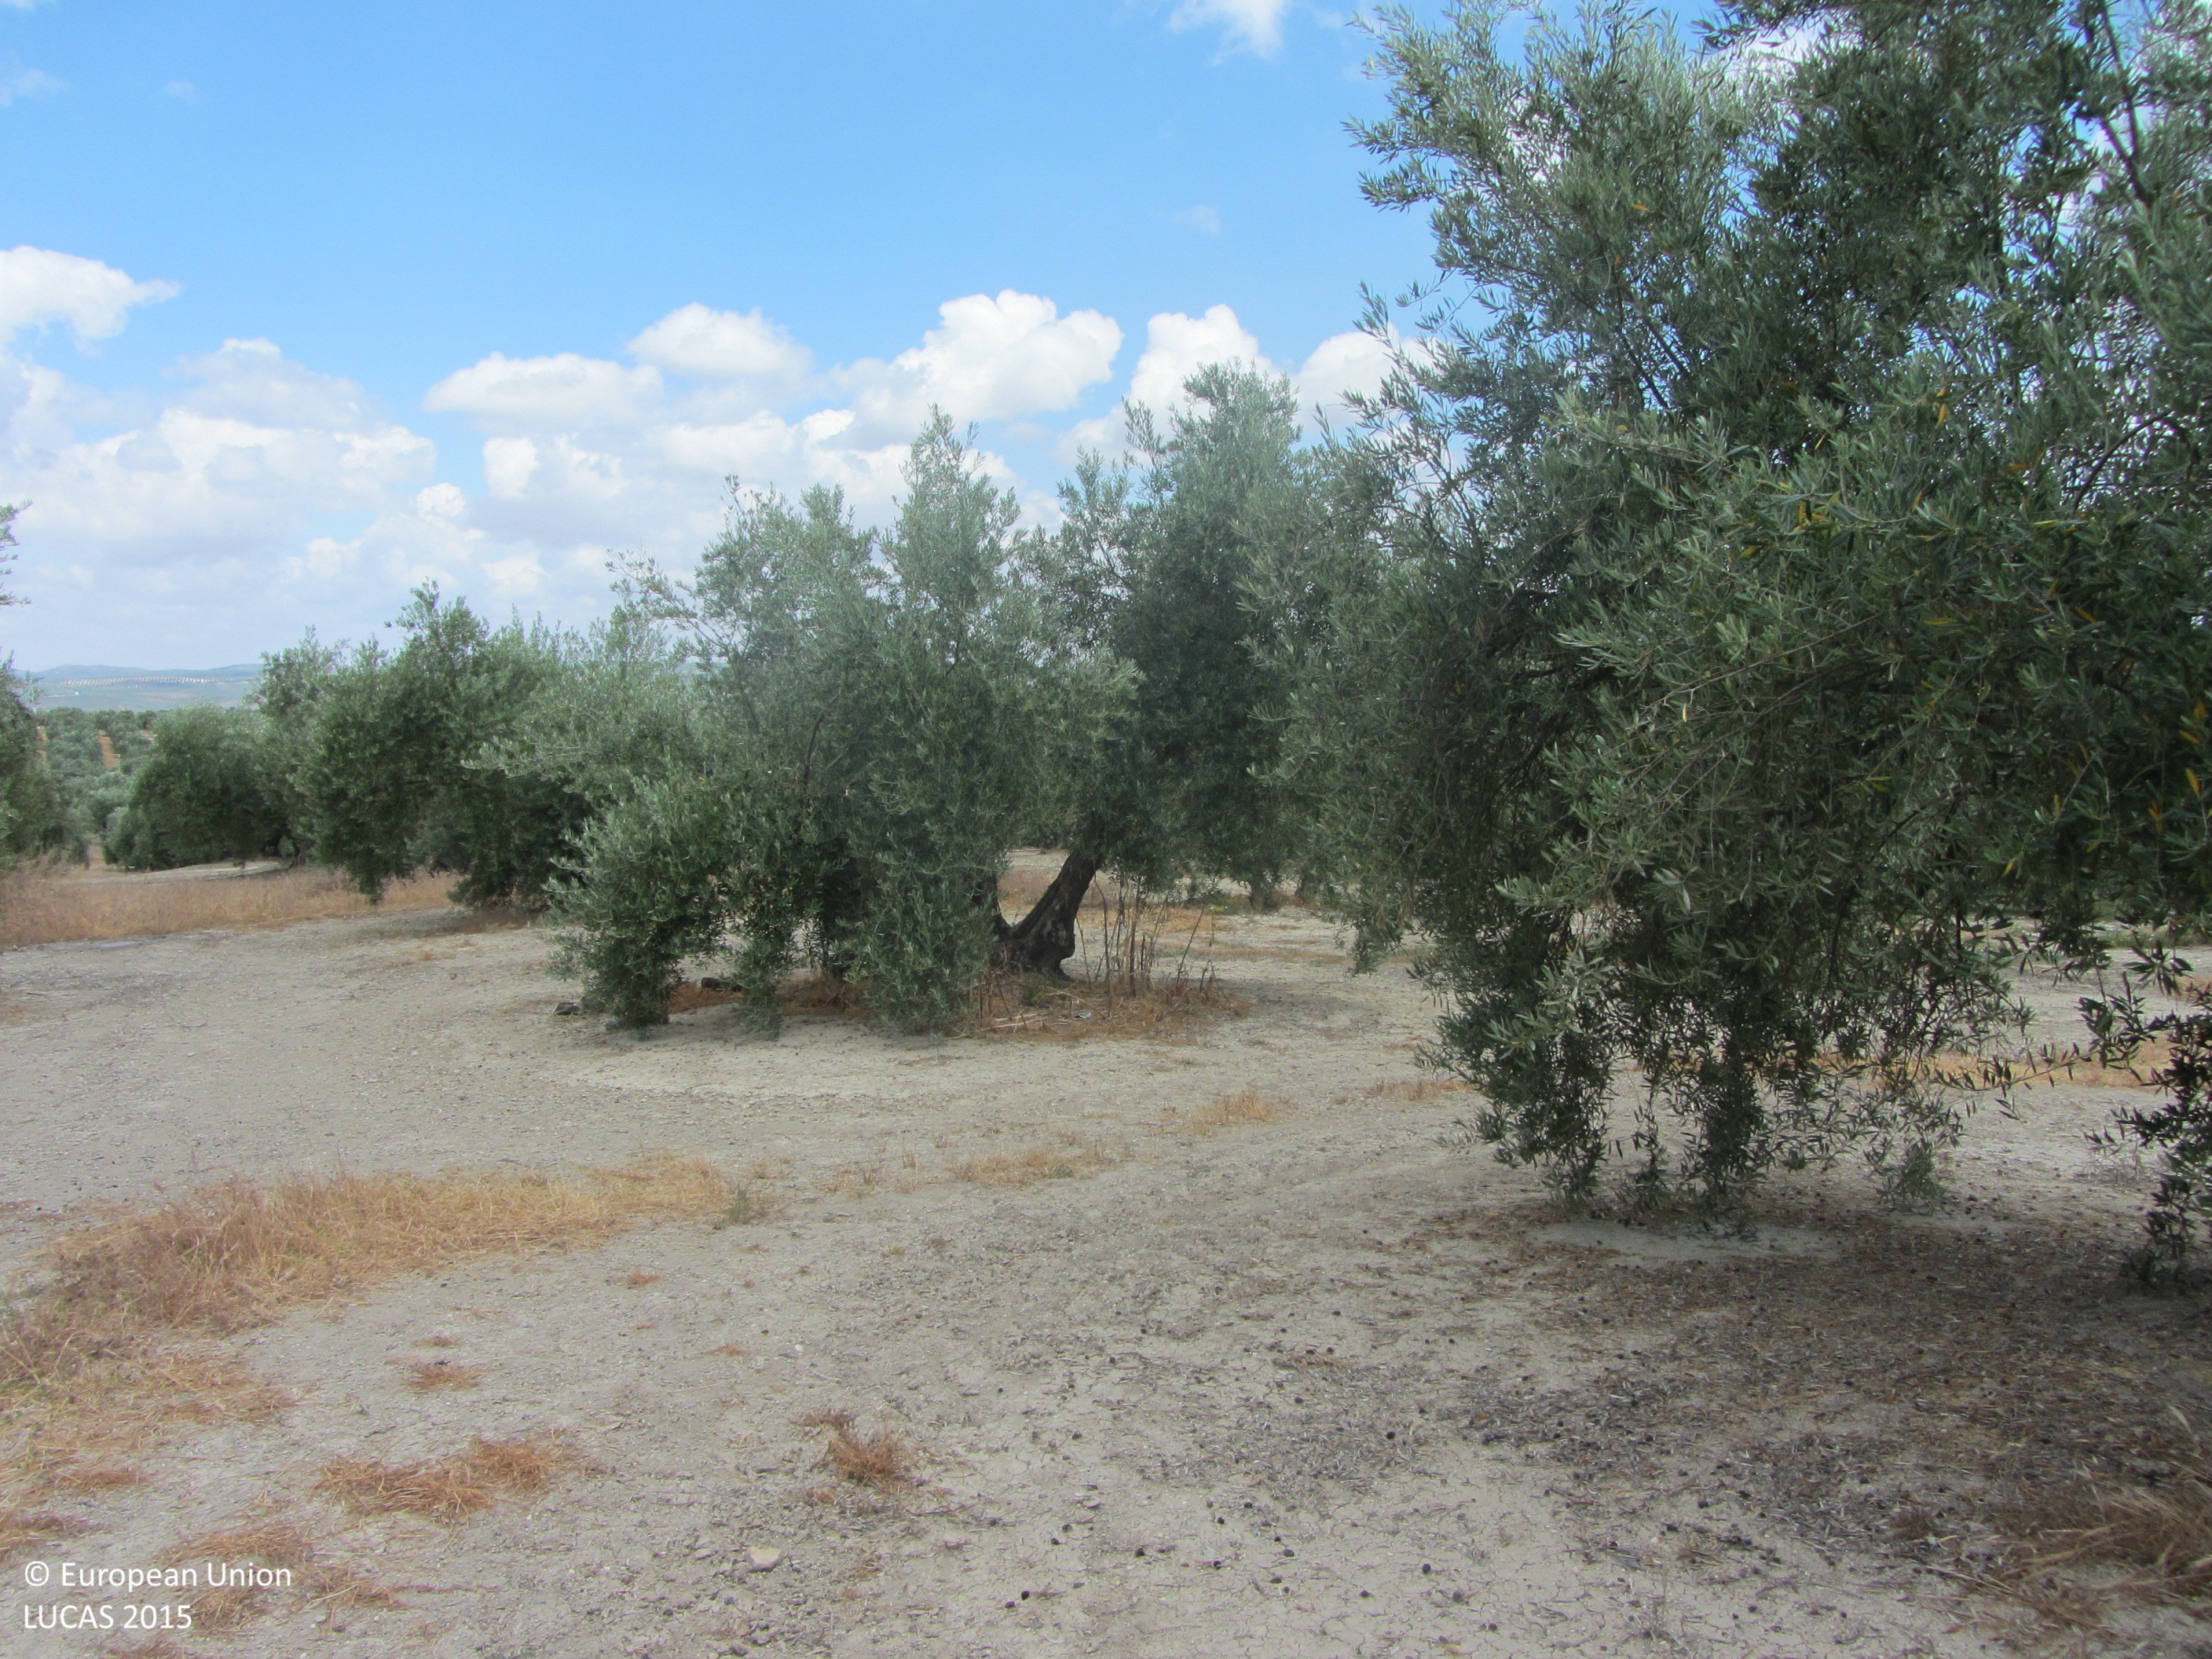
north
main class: Cropland
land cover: Olive groves
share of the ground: 25 - 50 %
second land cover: Other bare soil
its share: > 75 %
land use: Agriculture (excluding fallow land and kitchen gardens)
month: June
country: ES
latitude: 38.1380
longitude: -3.1088
